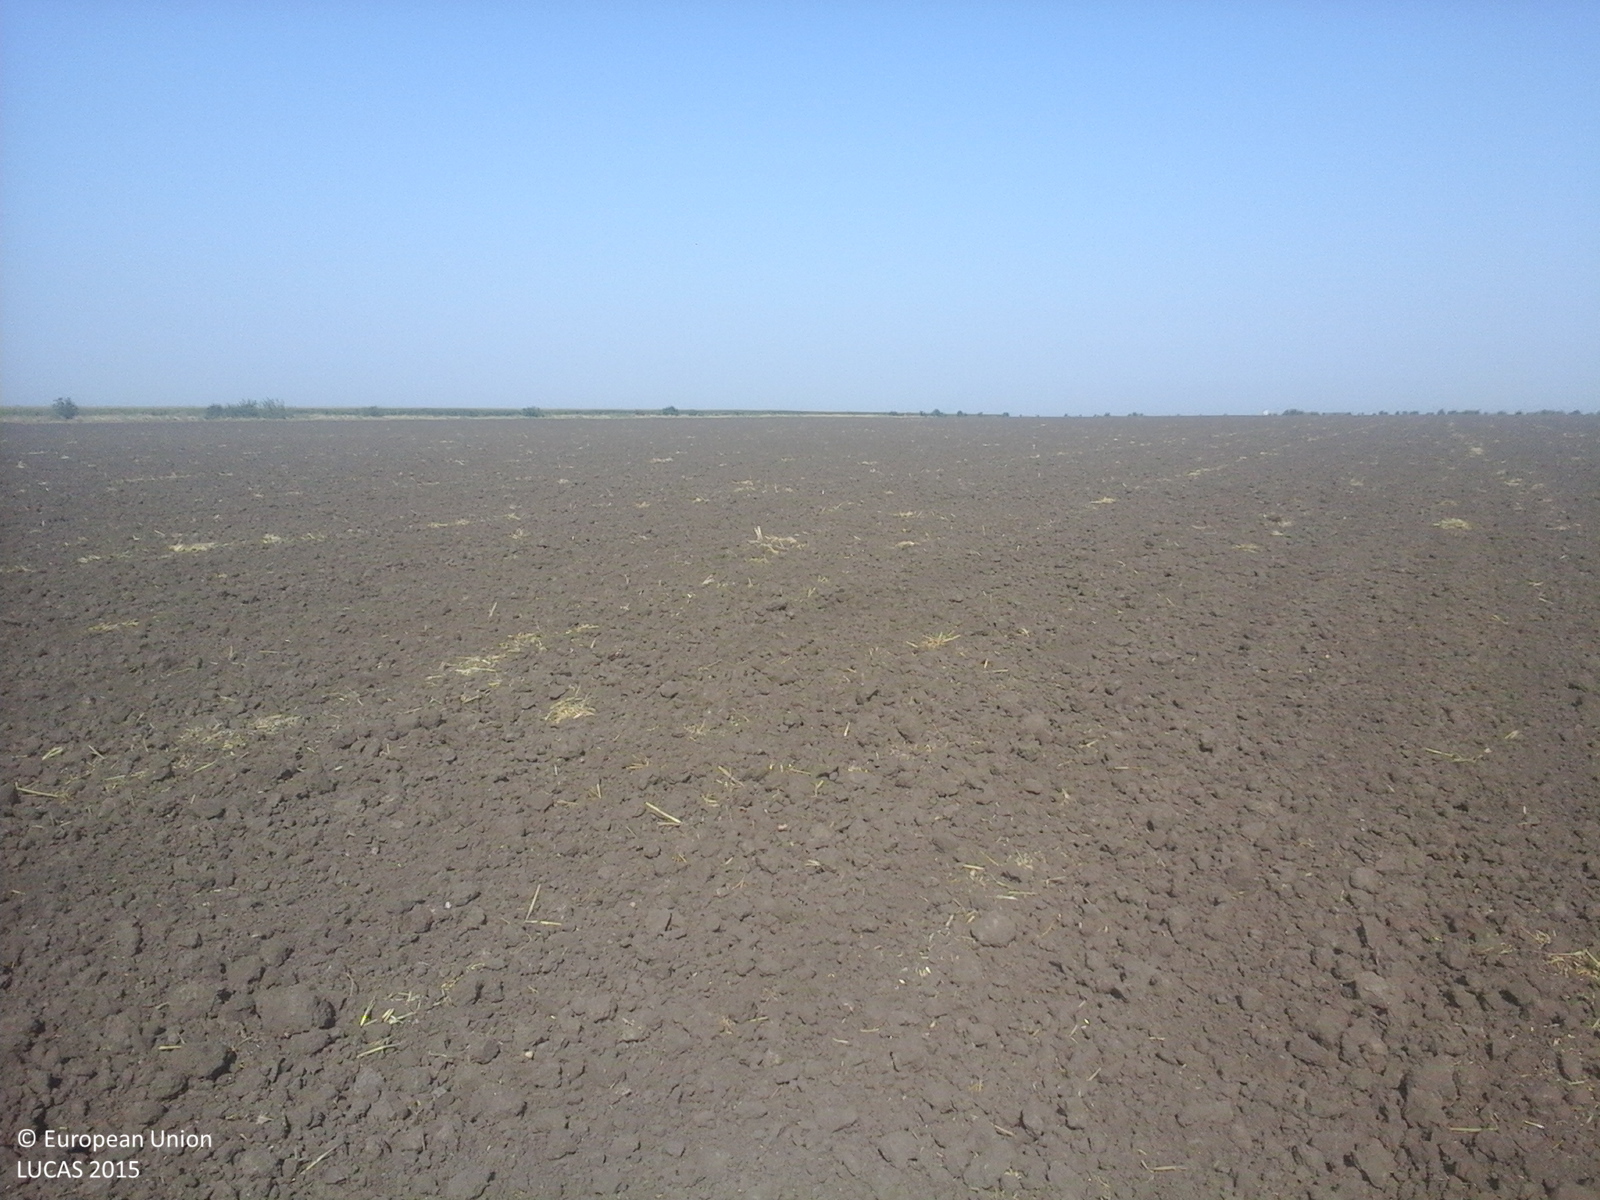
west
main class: Cropland
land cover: Durum wheat
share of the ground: < 10 %
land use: Agriculture (excluding fallow land and kitchen gardens)
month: July
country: RO
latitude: 44.3408
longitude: 27.1778
